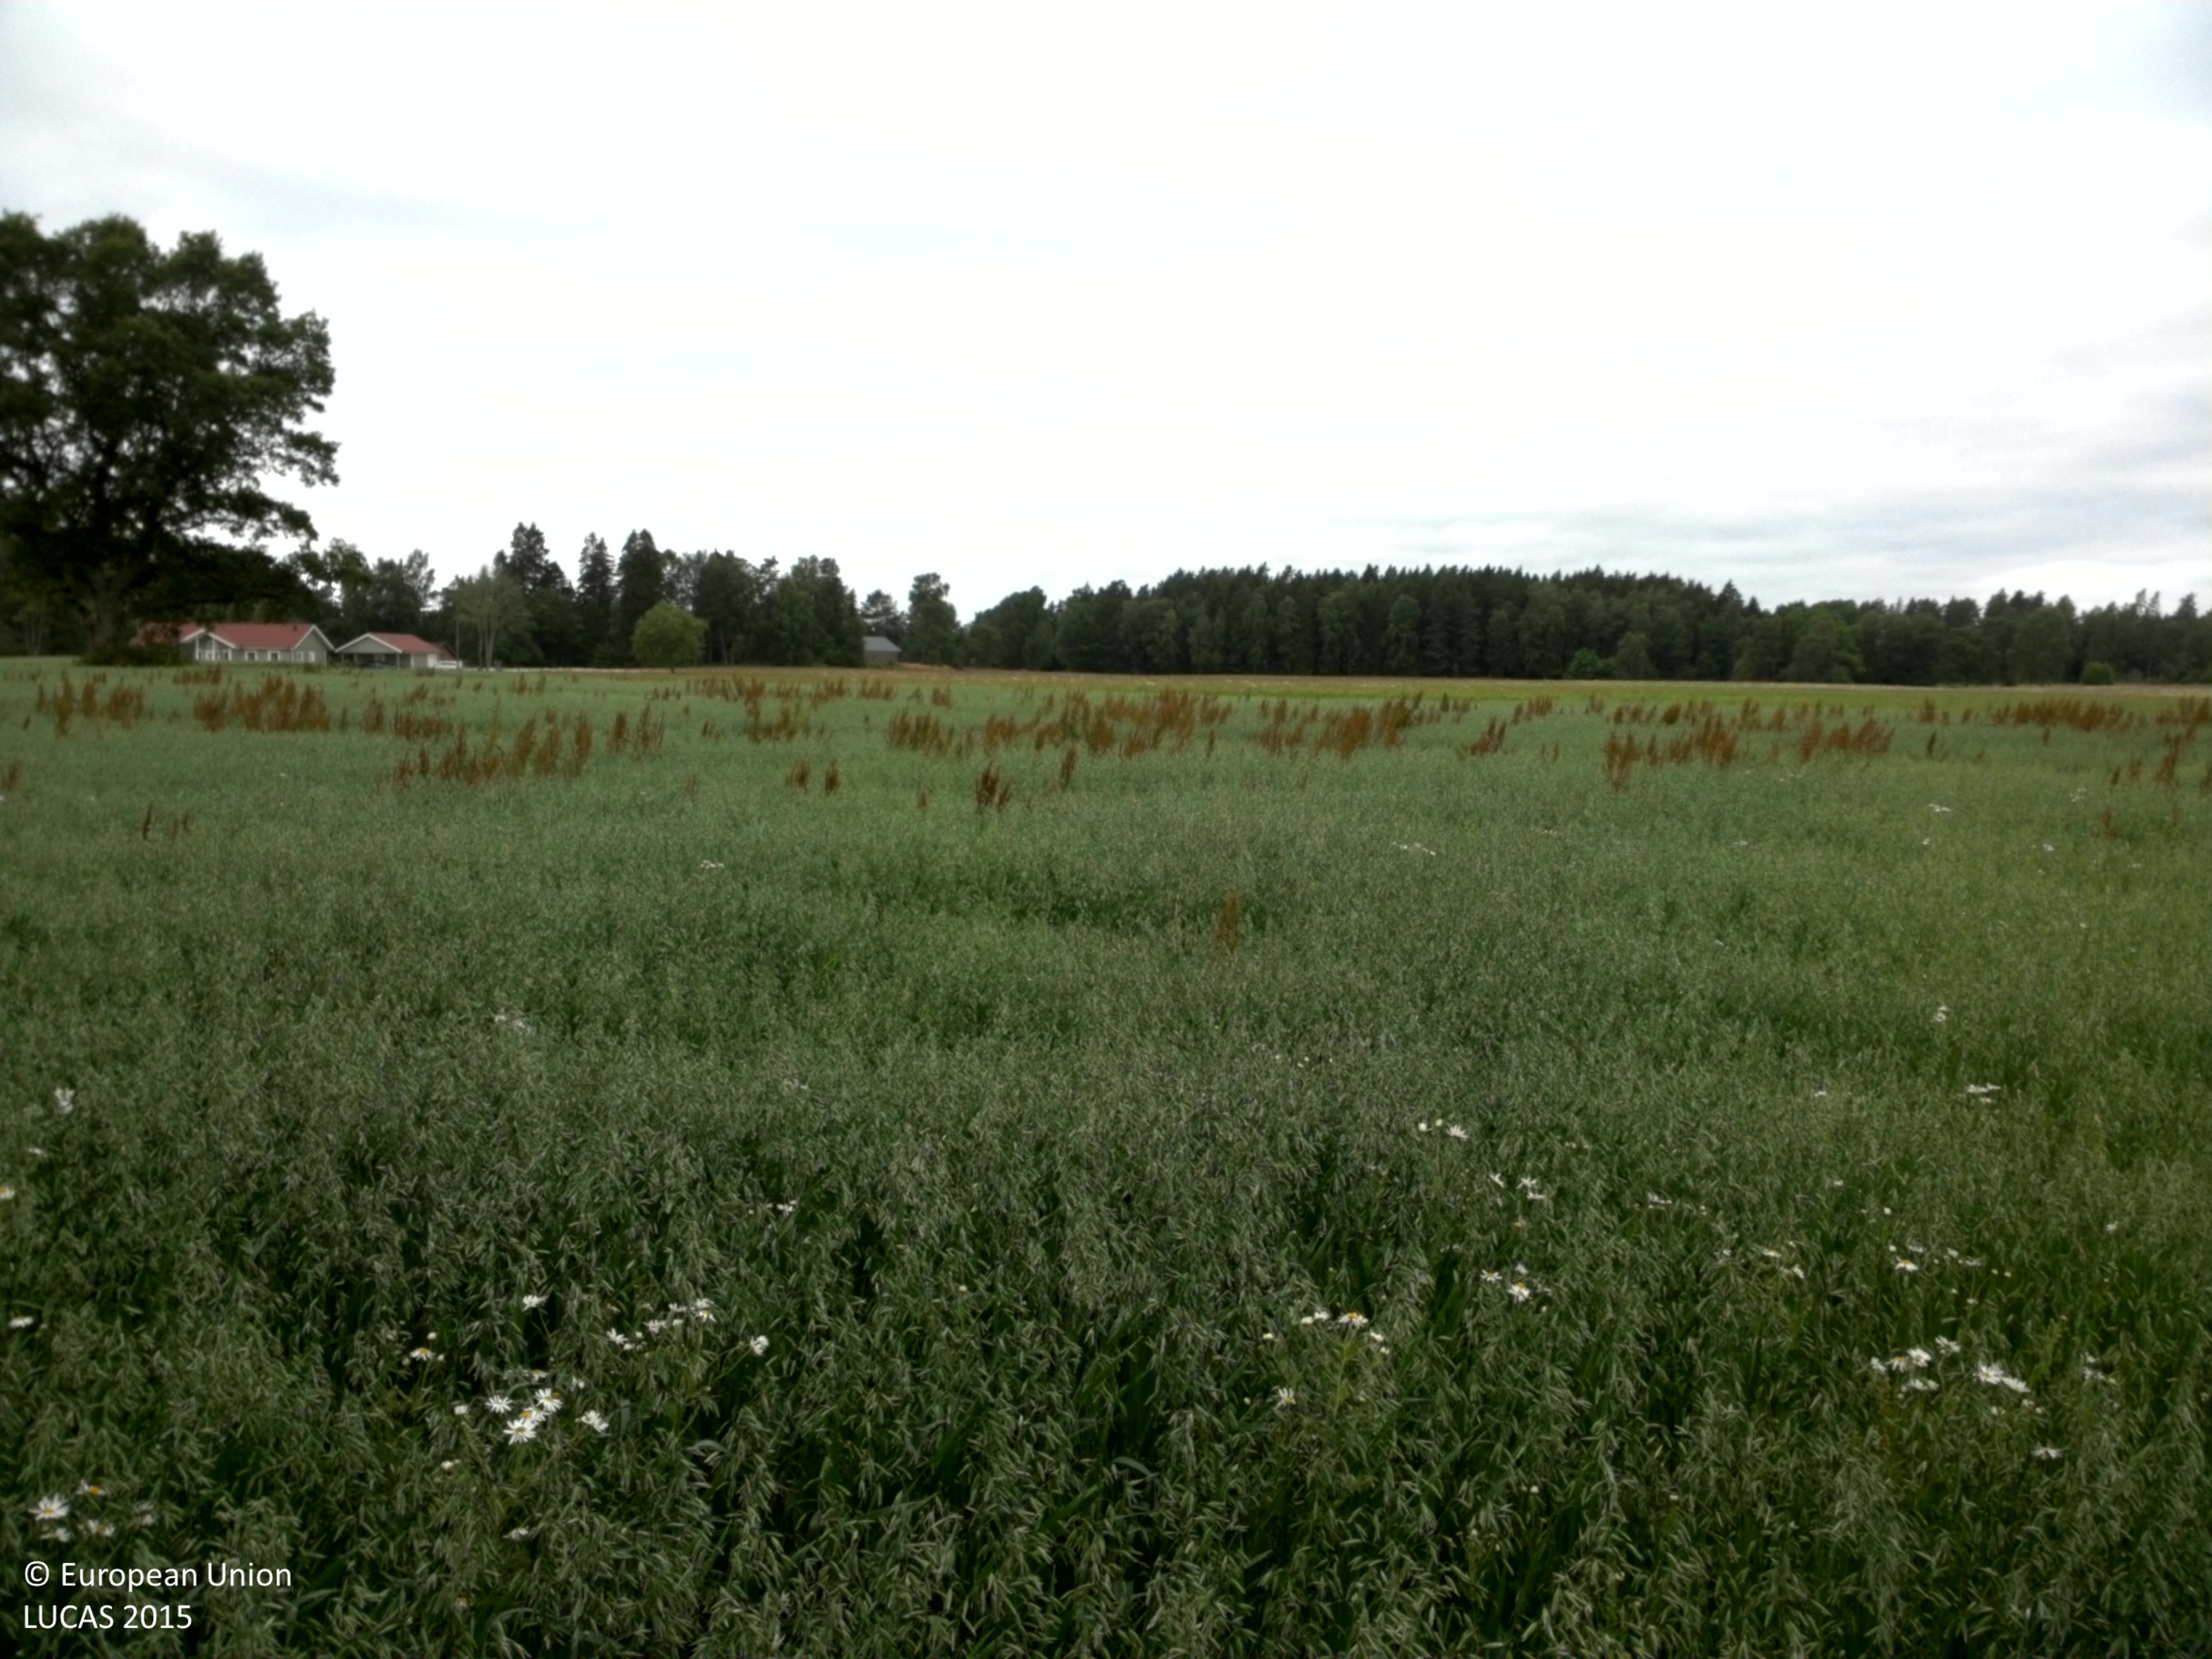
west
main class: Cropland
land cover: Oats
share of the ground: > 75 %
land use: Agriculture (excluding fallow land and kitchen gardens)
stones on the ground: 10 - 25 %
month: July
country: SE
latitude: 58.4482
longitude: 13.3352
